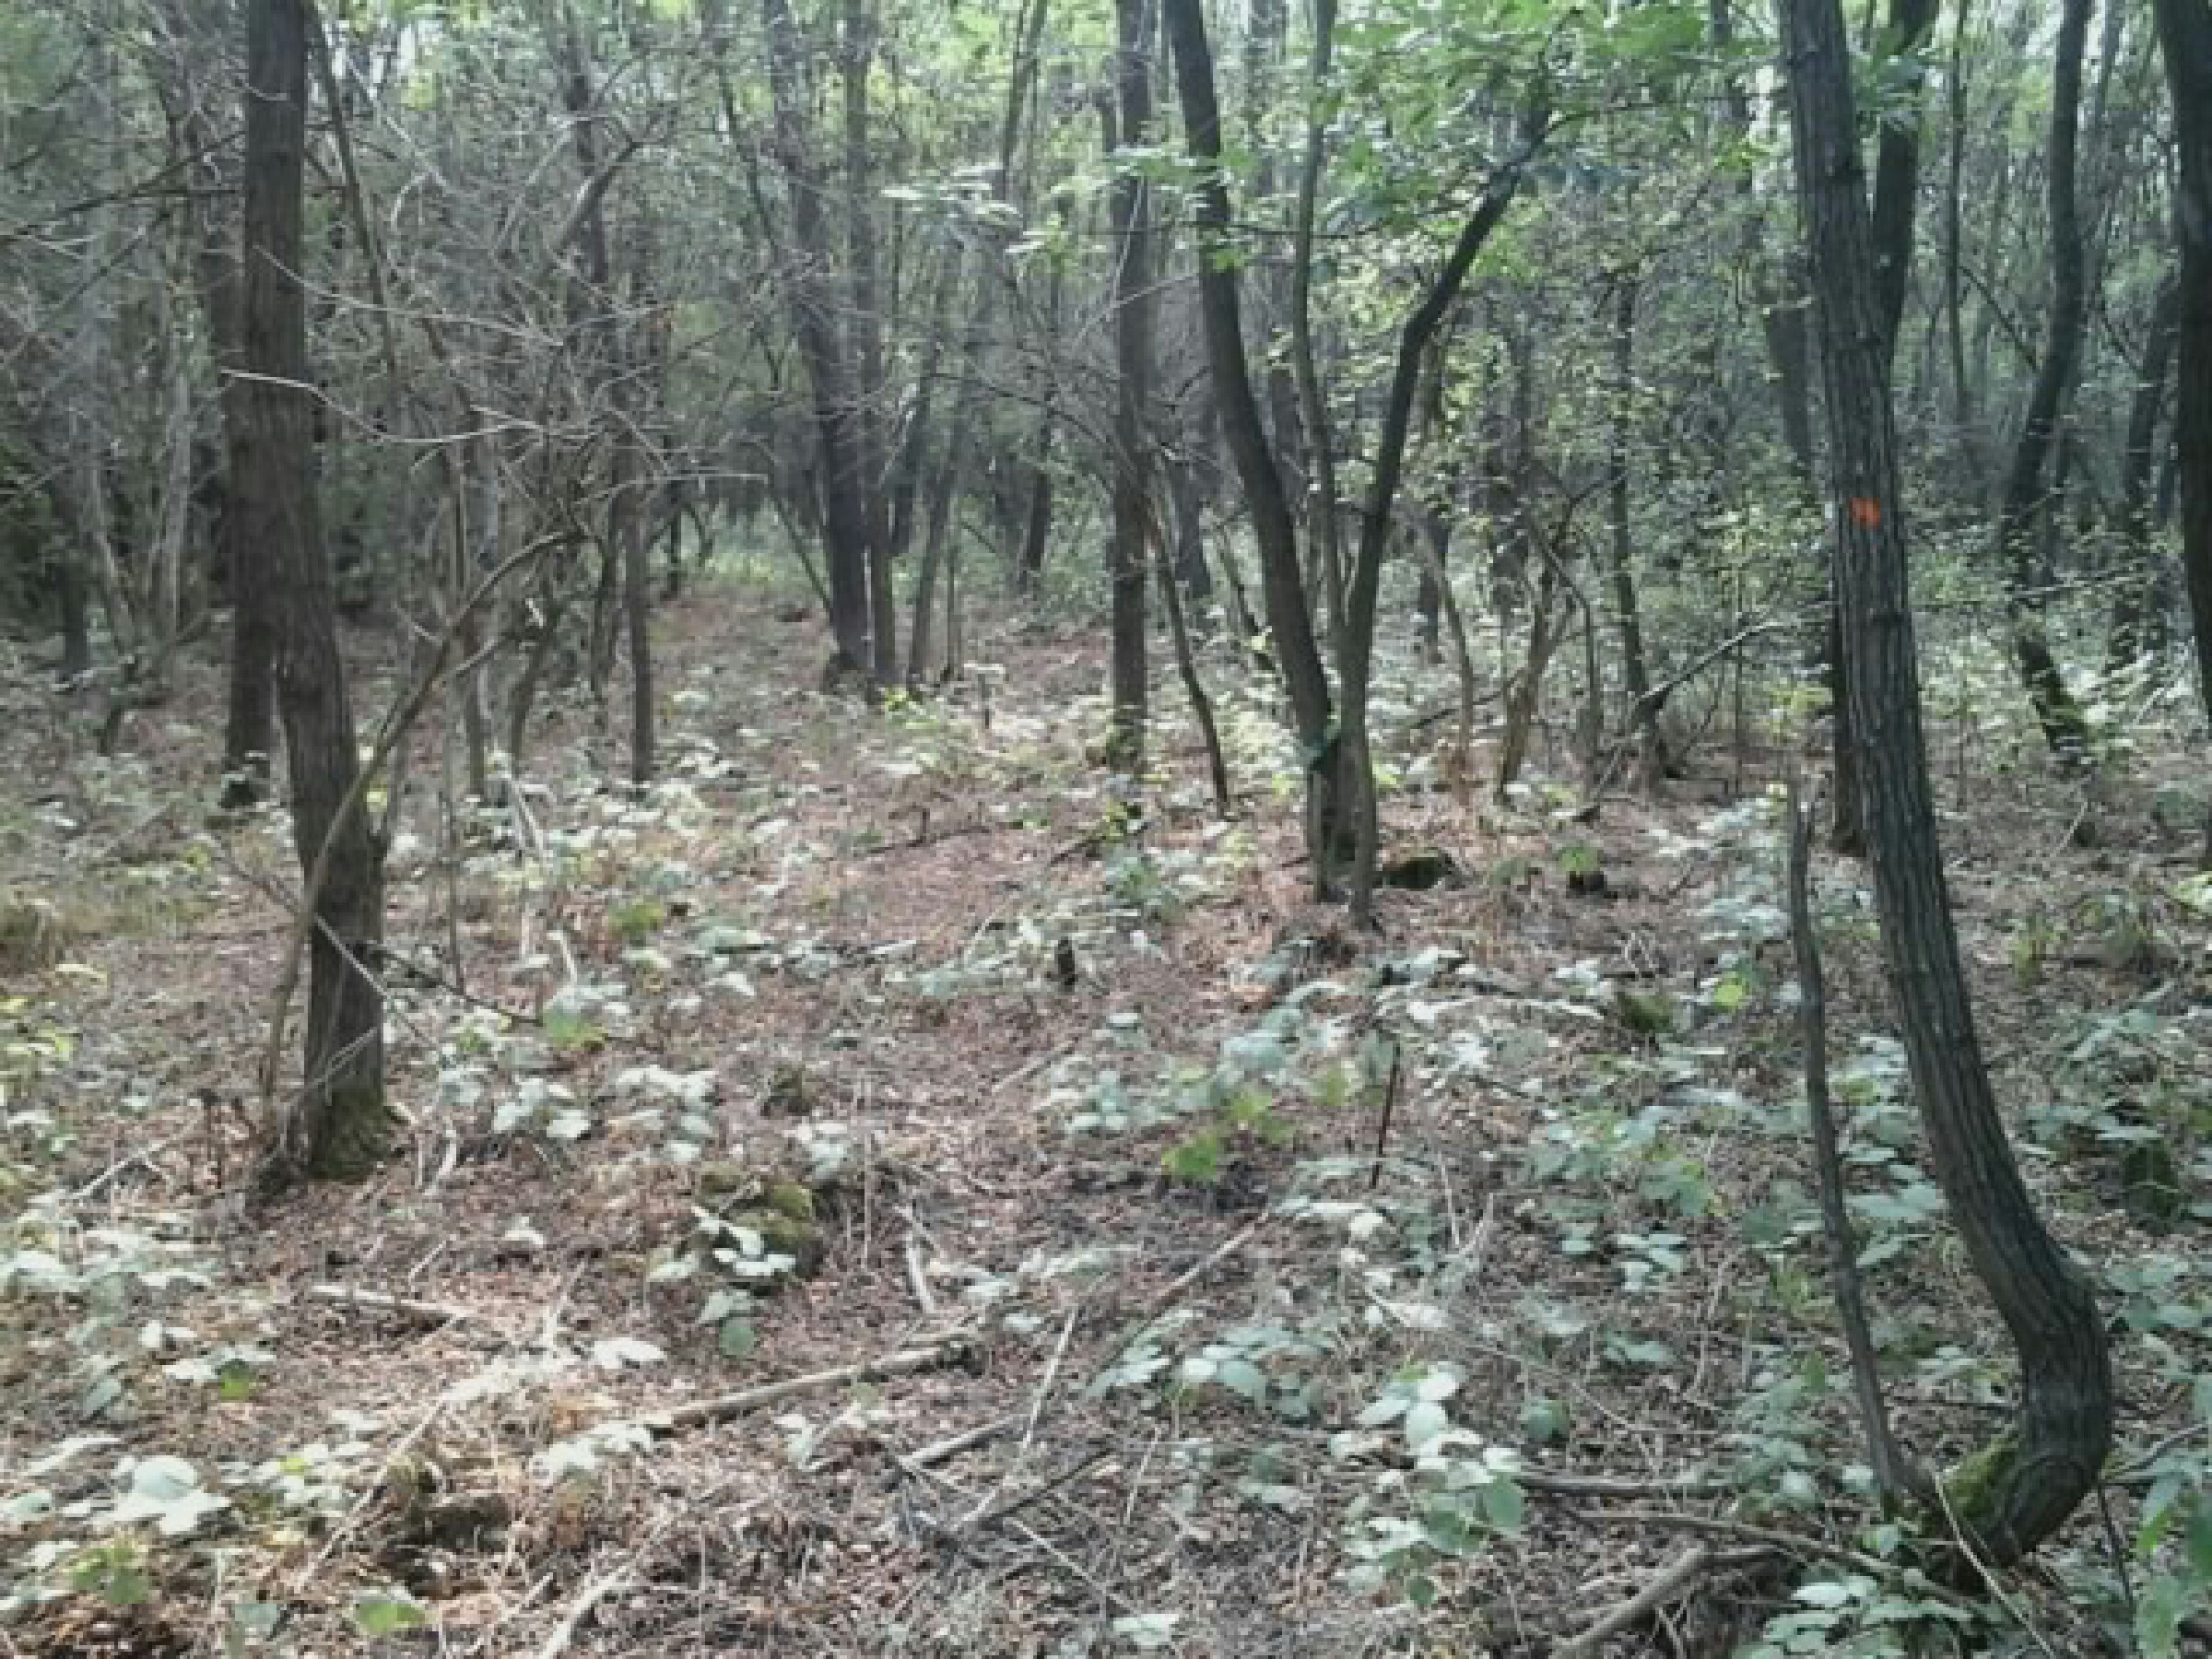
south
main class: Woodland
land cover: Broadleaved woodland
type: exotic forest
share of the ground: > 75 %
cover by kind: broadleaved forest trees 100 %
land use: Forestry
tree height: > 5 m
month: August
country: HU
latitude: 47.8535
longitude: 19.4446
